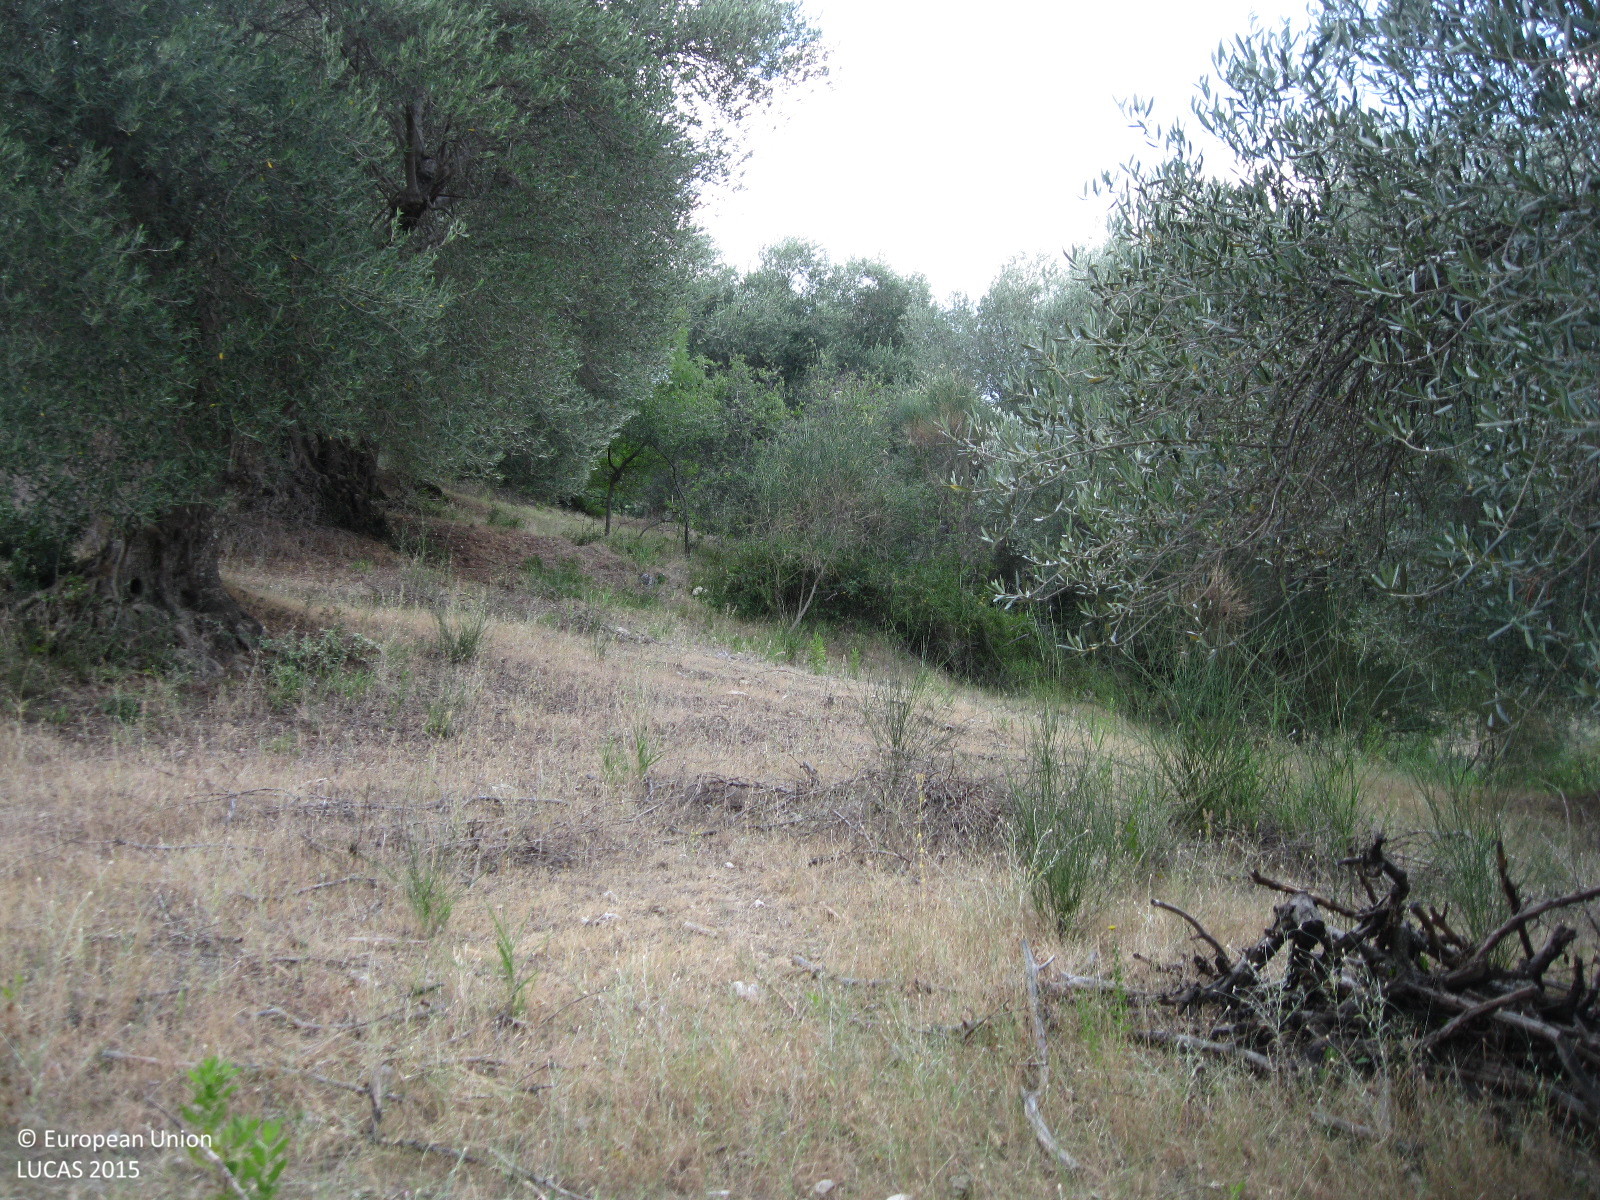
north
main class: Cropland
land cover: Olive groves
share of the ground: > 75 %
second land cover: Grassland without tree/shrub cover
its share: 50 - 75 %
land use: Agriculture (excluding fallow land and kitchen gardens)
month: July
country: IT
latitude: 42.6979
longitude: 11.4479
